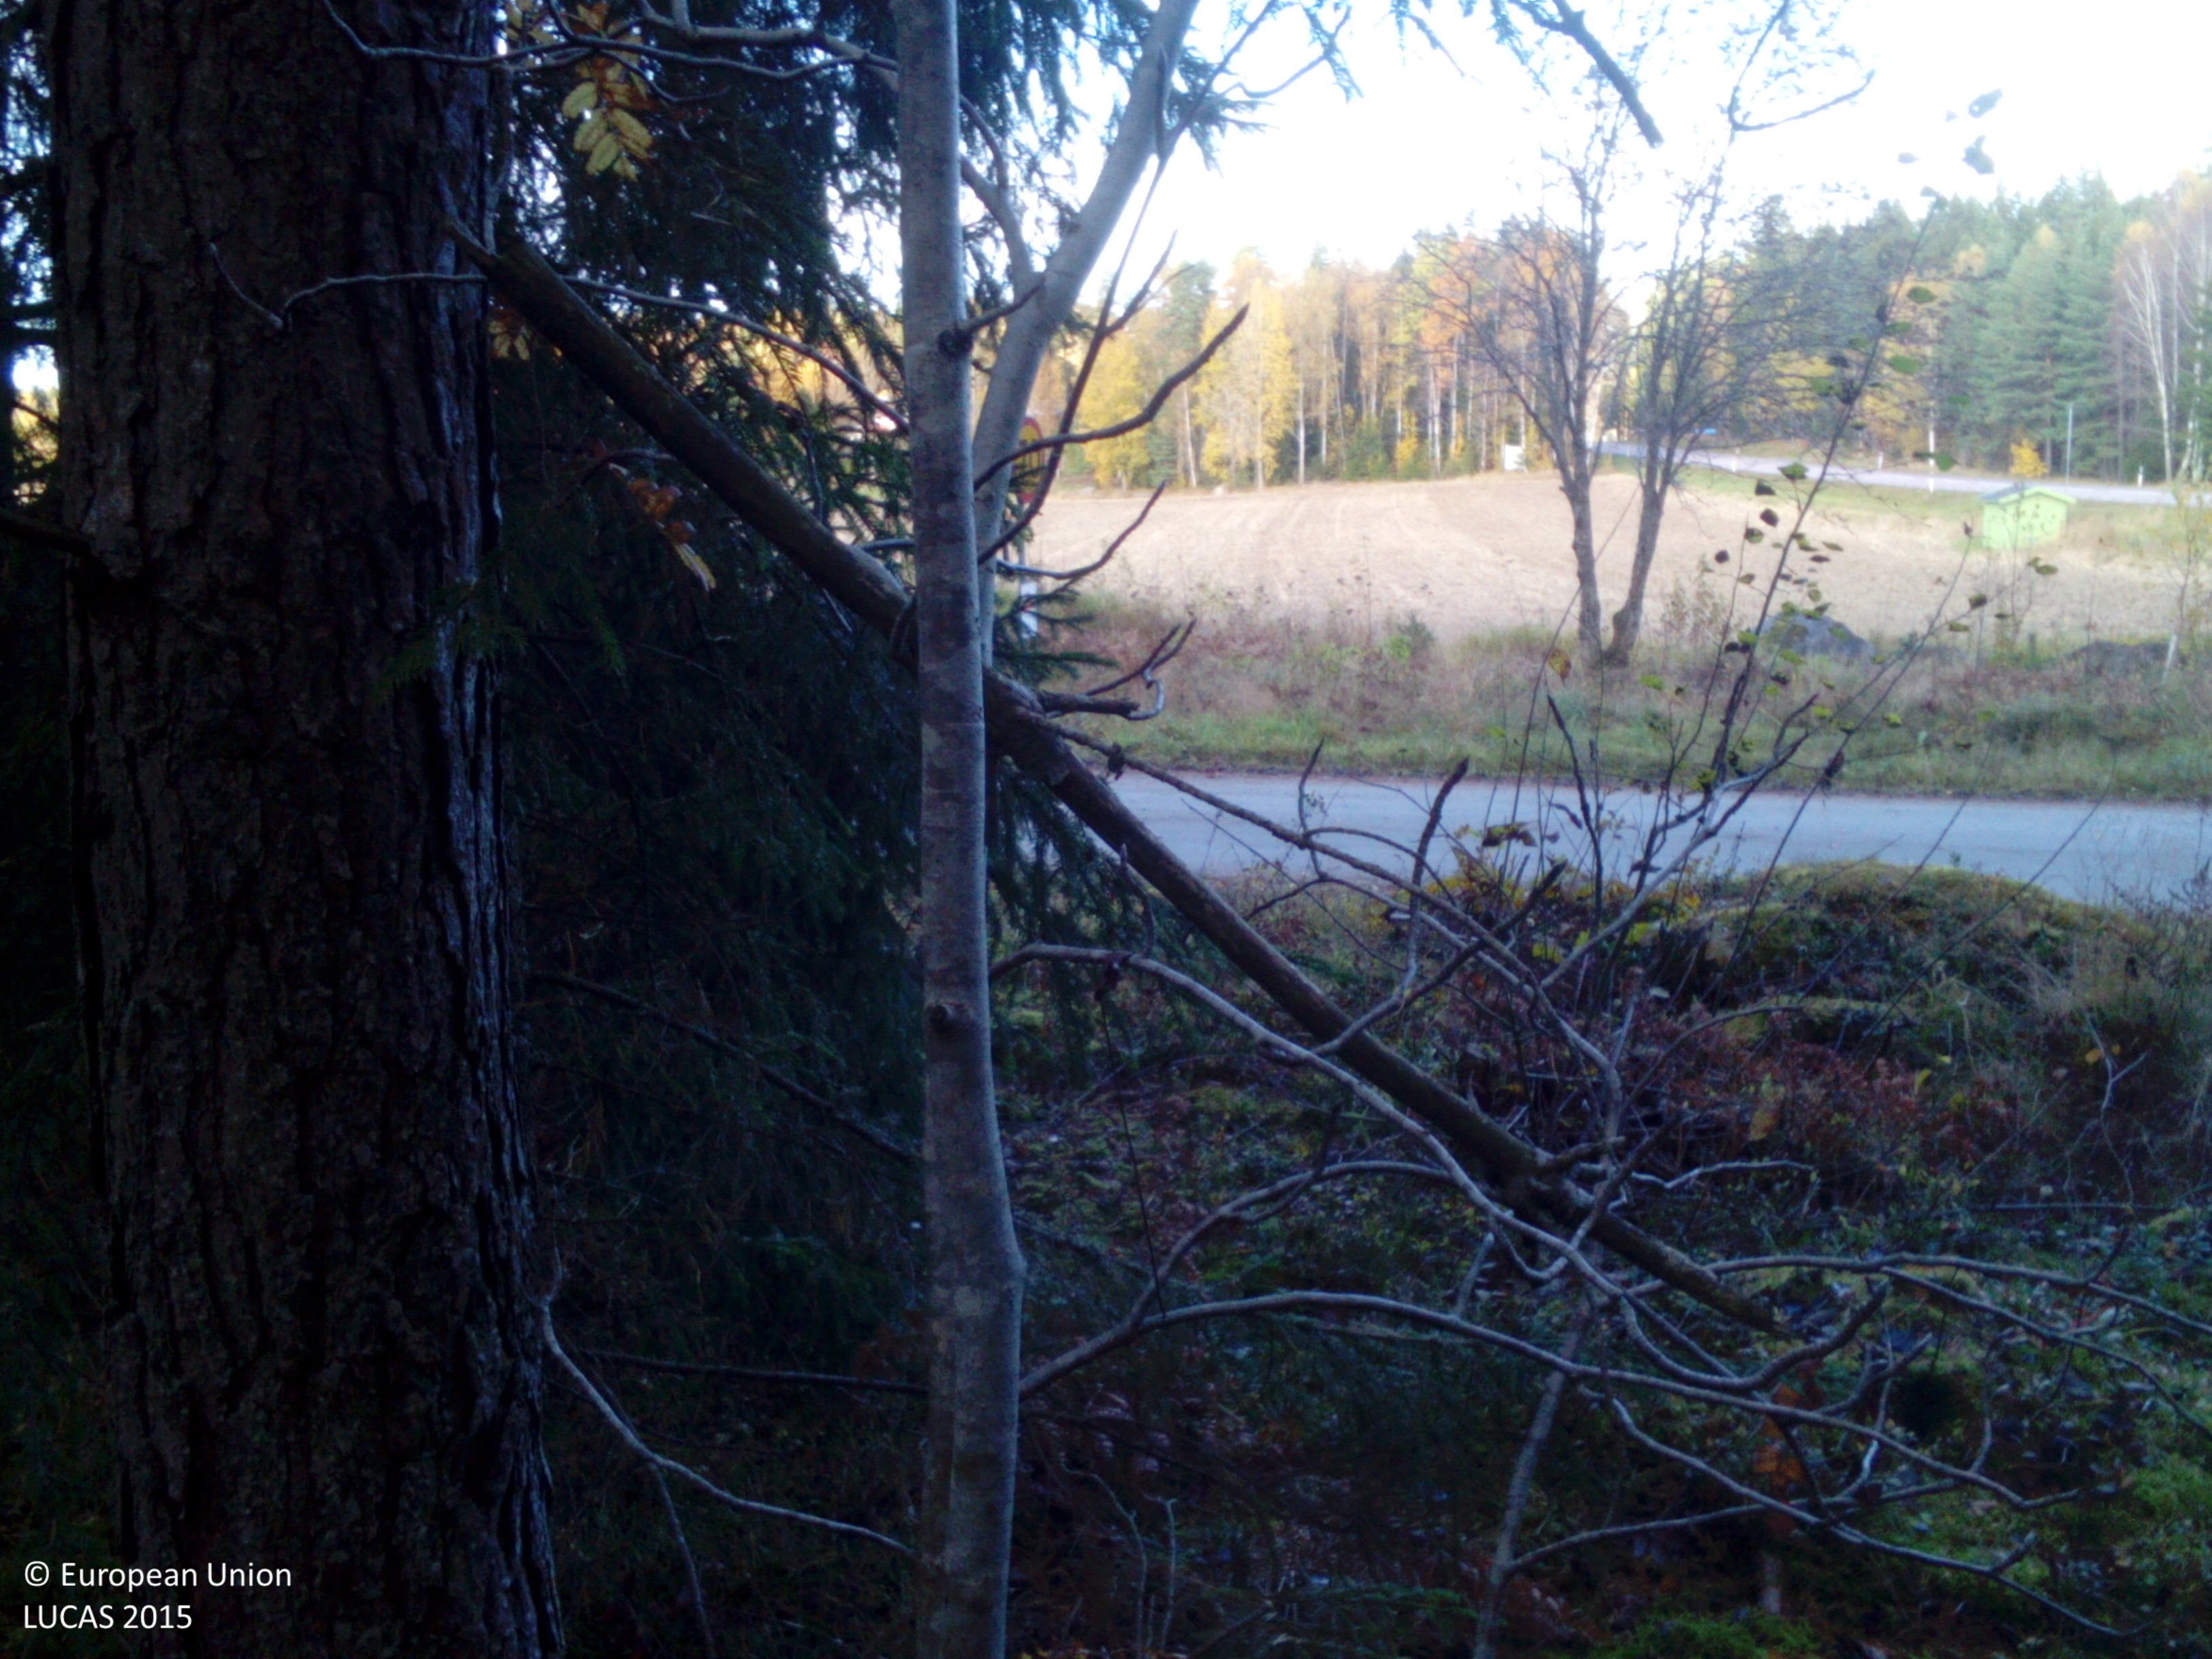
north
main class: Woodland
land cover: Other coniferous woodland
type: boreal forest
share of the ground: > 75 %
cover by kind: coniferous forest trees 85 %, lichens and mosses 10 %, herbaceous plants 5 %
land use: Forestry
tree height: > 5 m
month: October
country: SE
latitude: 59.0325
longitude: 16.2139
